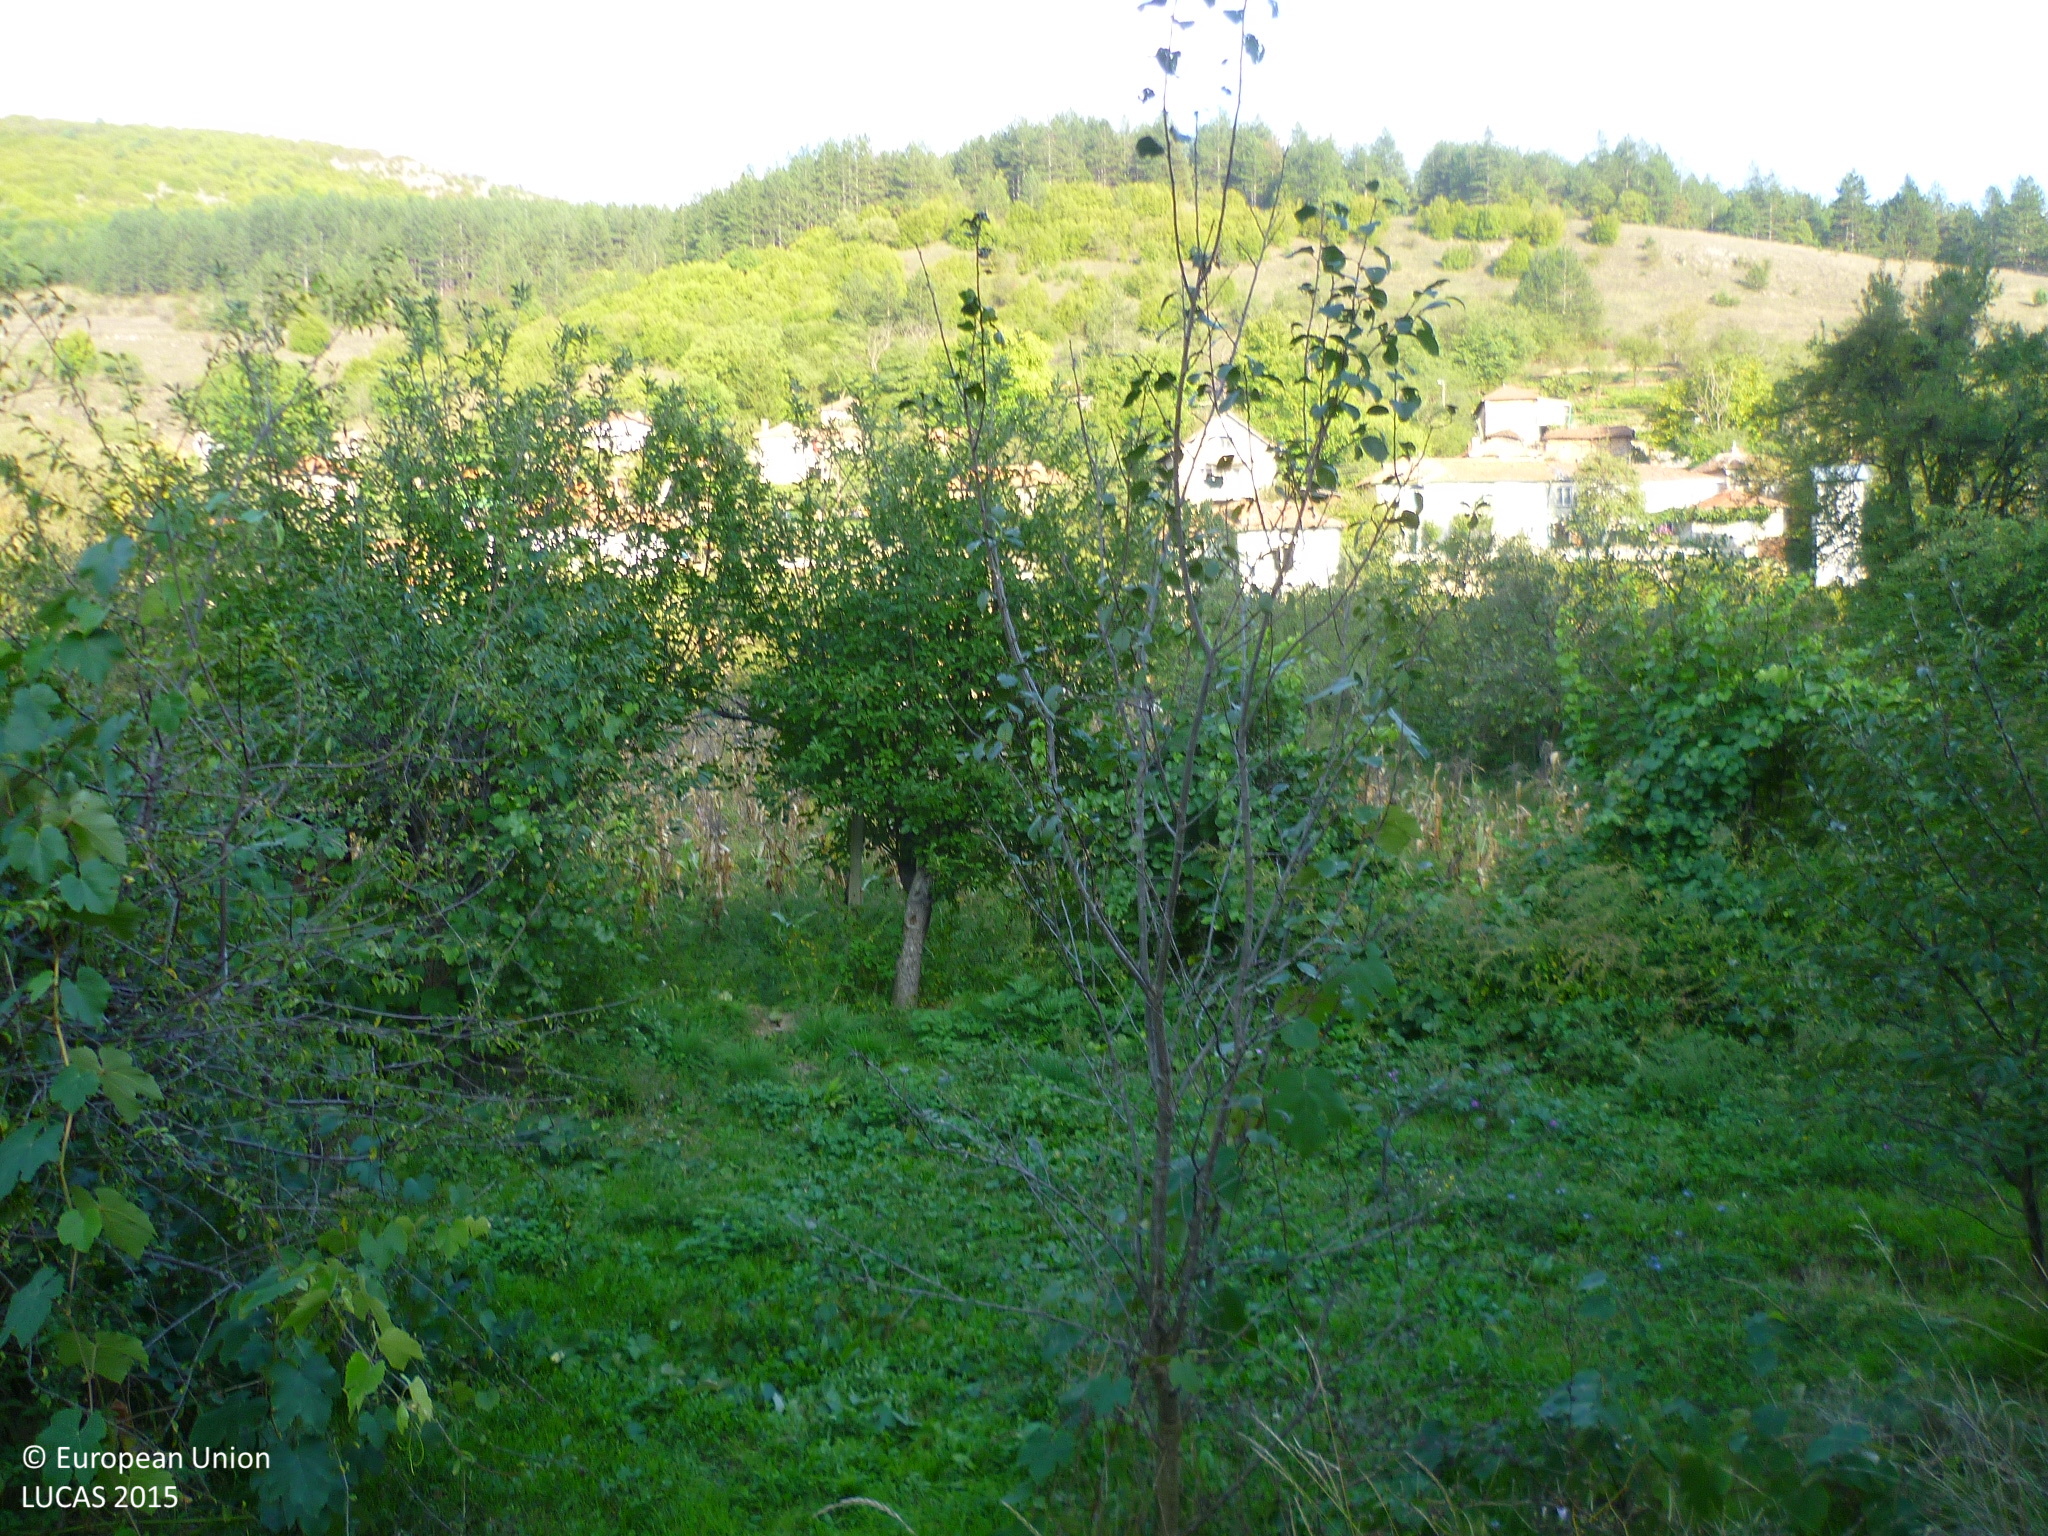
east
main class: Grassland
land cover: Grassland with sparse tree/shrub cover
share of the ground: 50 - 75 %
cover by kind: herbaceous plants 45 %, broadleaved forest trees 5 %, shrubs 5 %
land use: Residential
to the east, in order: Grassland with sparse tree/shrub cover; Artificial constructions in urban areas; Rivers and streams; Artificial constructions in urban areas; Grassland with sparse tree/shrub cover; Broadleaved woodland
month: October
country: BG
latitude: 42.9147
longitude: 22.8057
